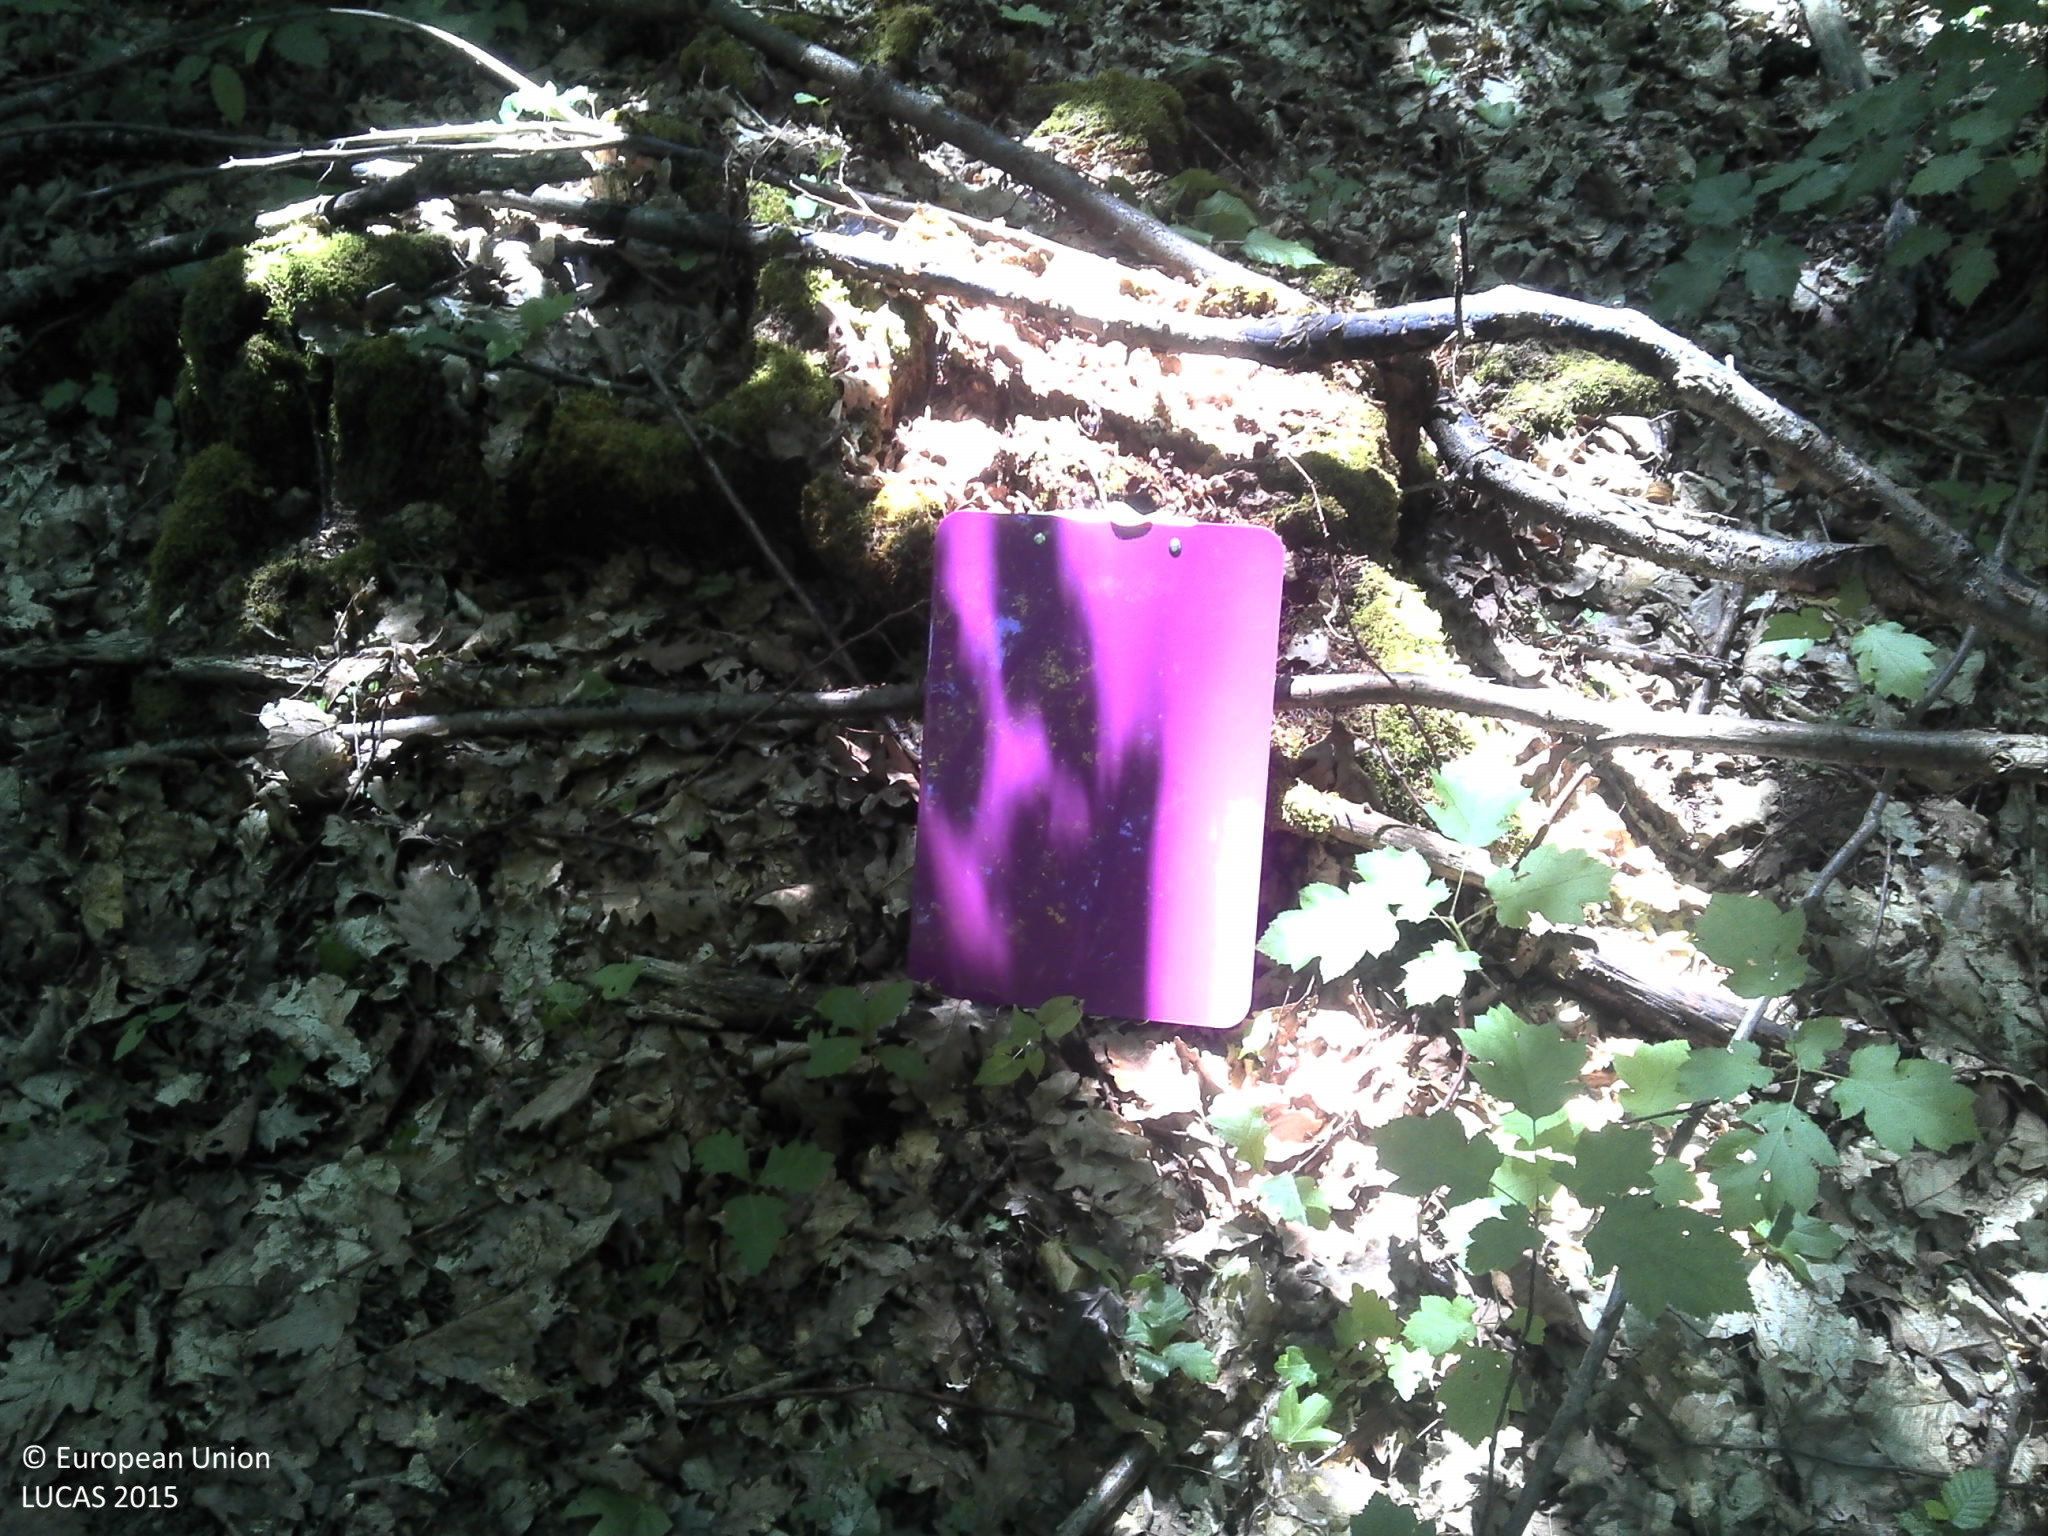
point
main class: Woodland
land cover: Broadleaved woodland
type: hemiboreal forest and nemoral coniferous forest and mixed broadleaved-coniferous forest
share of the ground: > 75 %
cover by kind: broadleaved forest trees 80 %, lichens and mosses 20 %
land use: Forestry
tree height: > 5 m
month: May
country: HR
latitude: 45.3094
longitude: 18.2309
